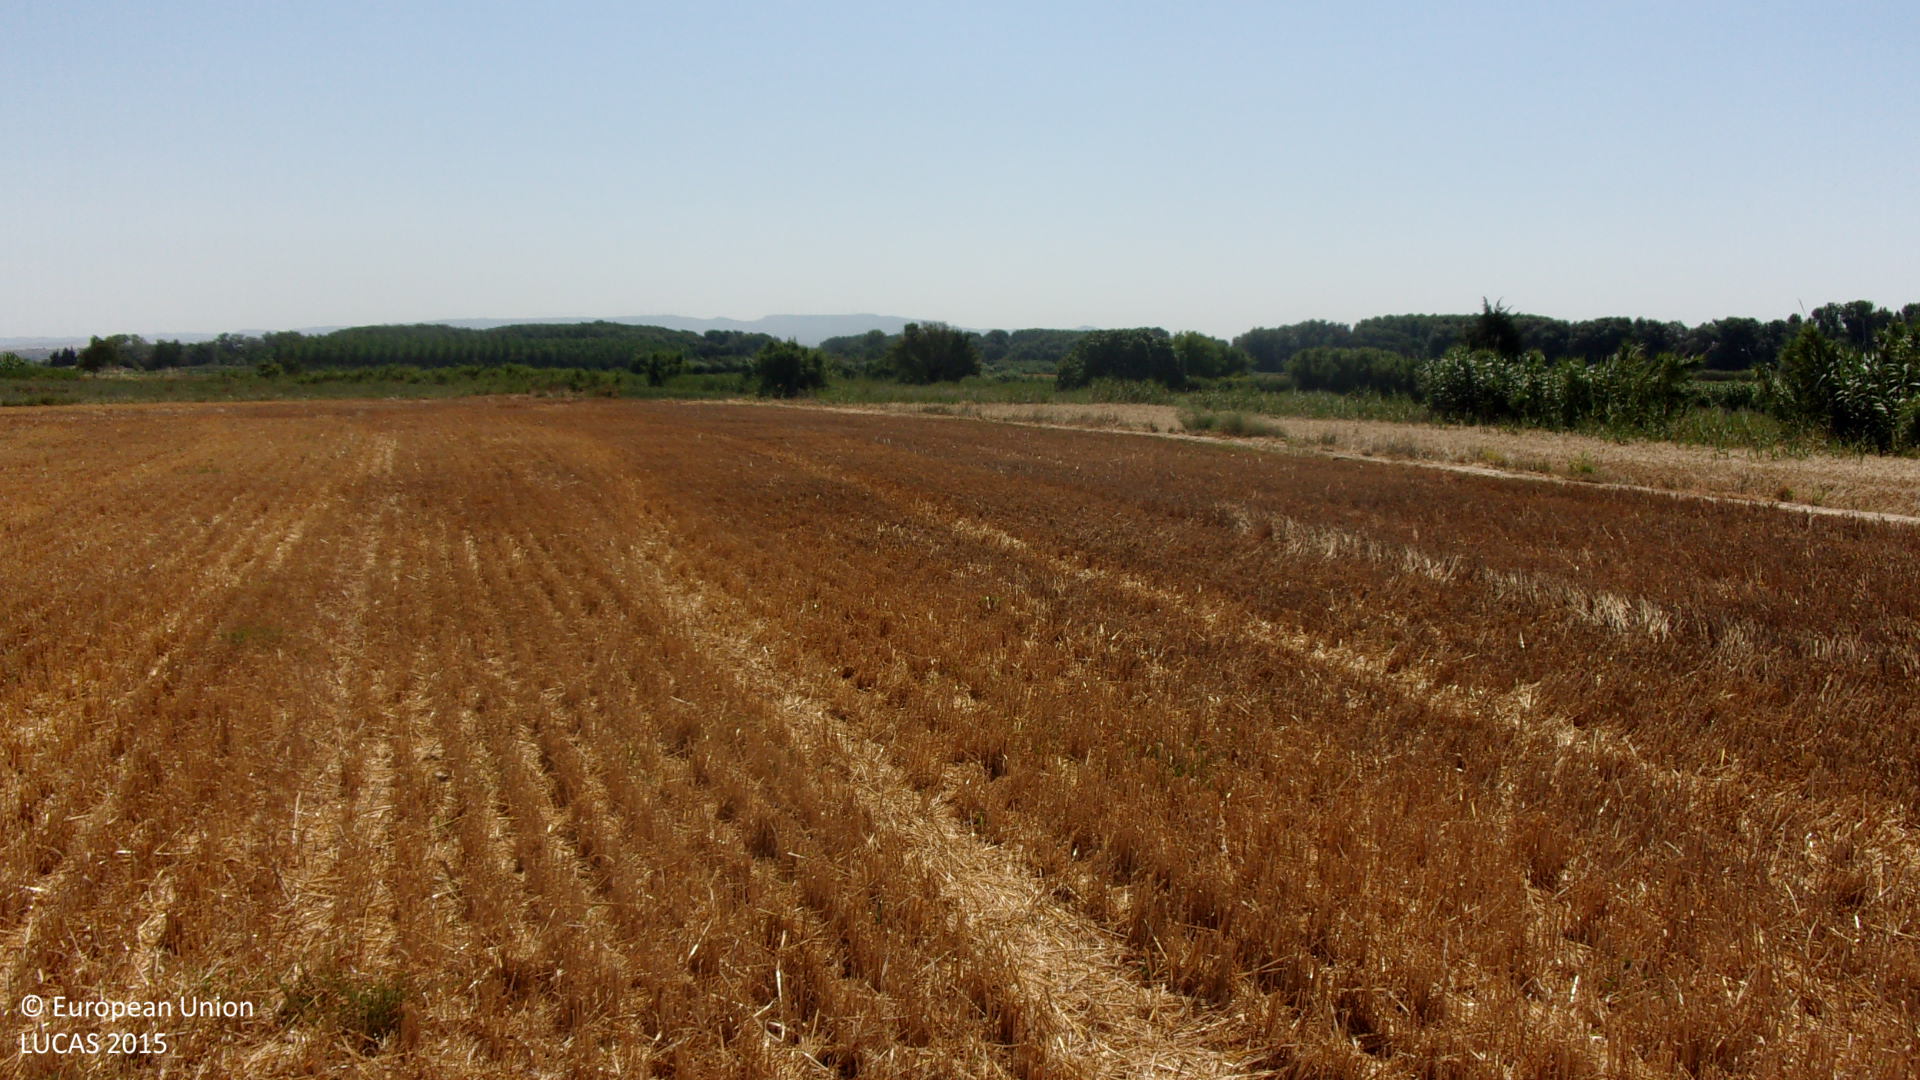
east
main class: Cropland
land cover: Durum wheat
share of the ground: < 10 %
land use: Agriculture (excluding fallow land and kitchen gardens)
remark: Harvested field
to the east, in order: Durum wheat; Spontaneously vegetated surfaces; Common wheat; Grass margins; Lucerne; Shruby margins; Grassland without tree/shrub cover
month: July
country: ES
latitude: 41.8746
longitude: -1.2932
